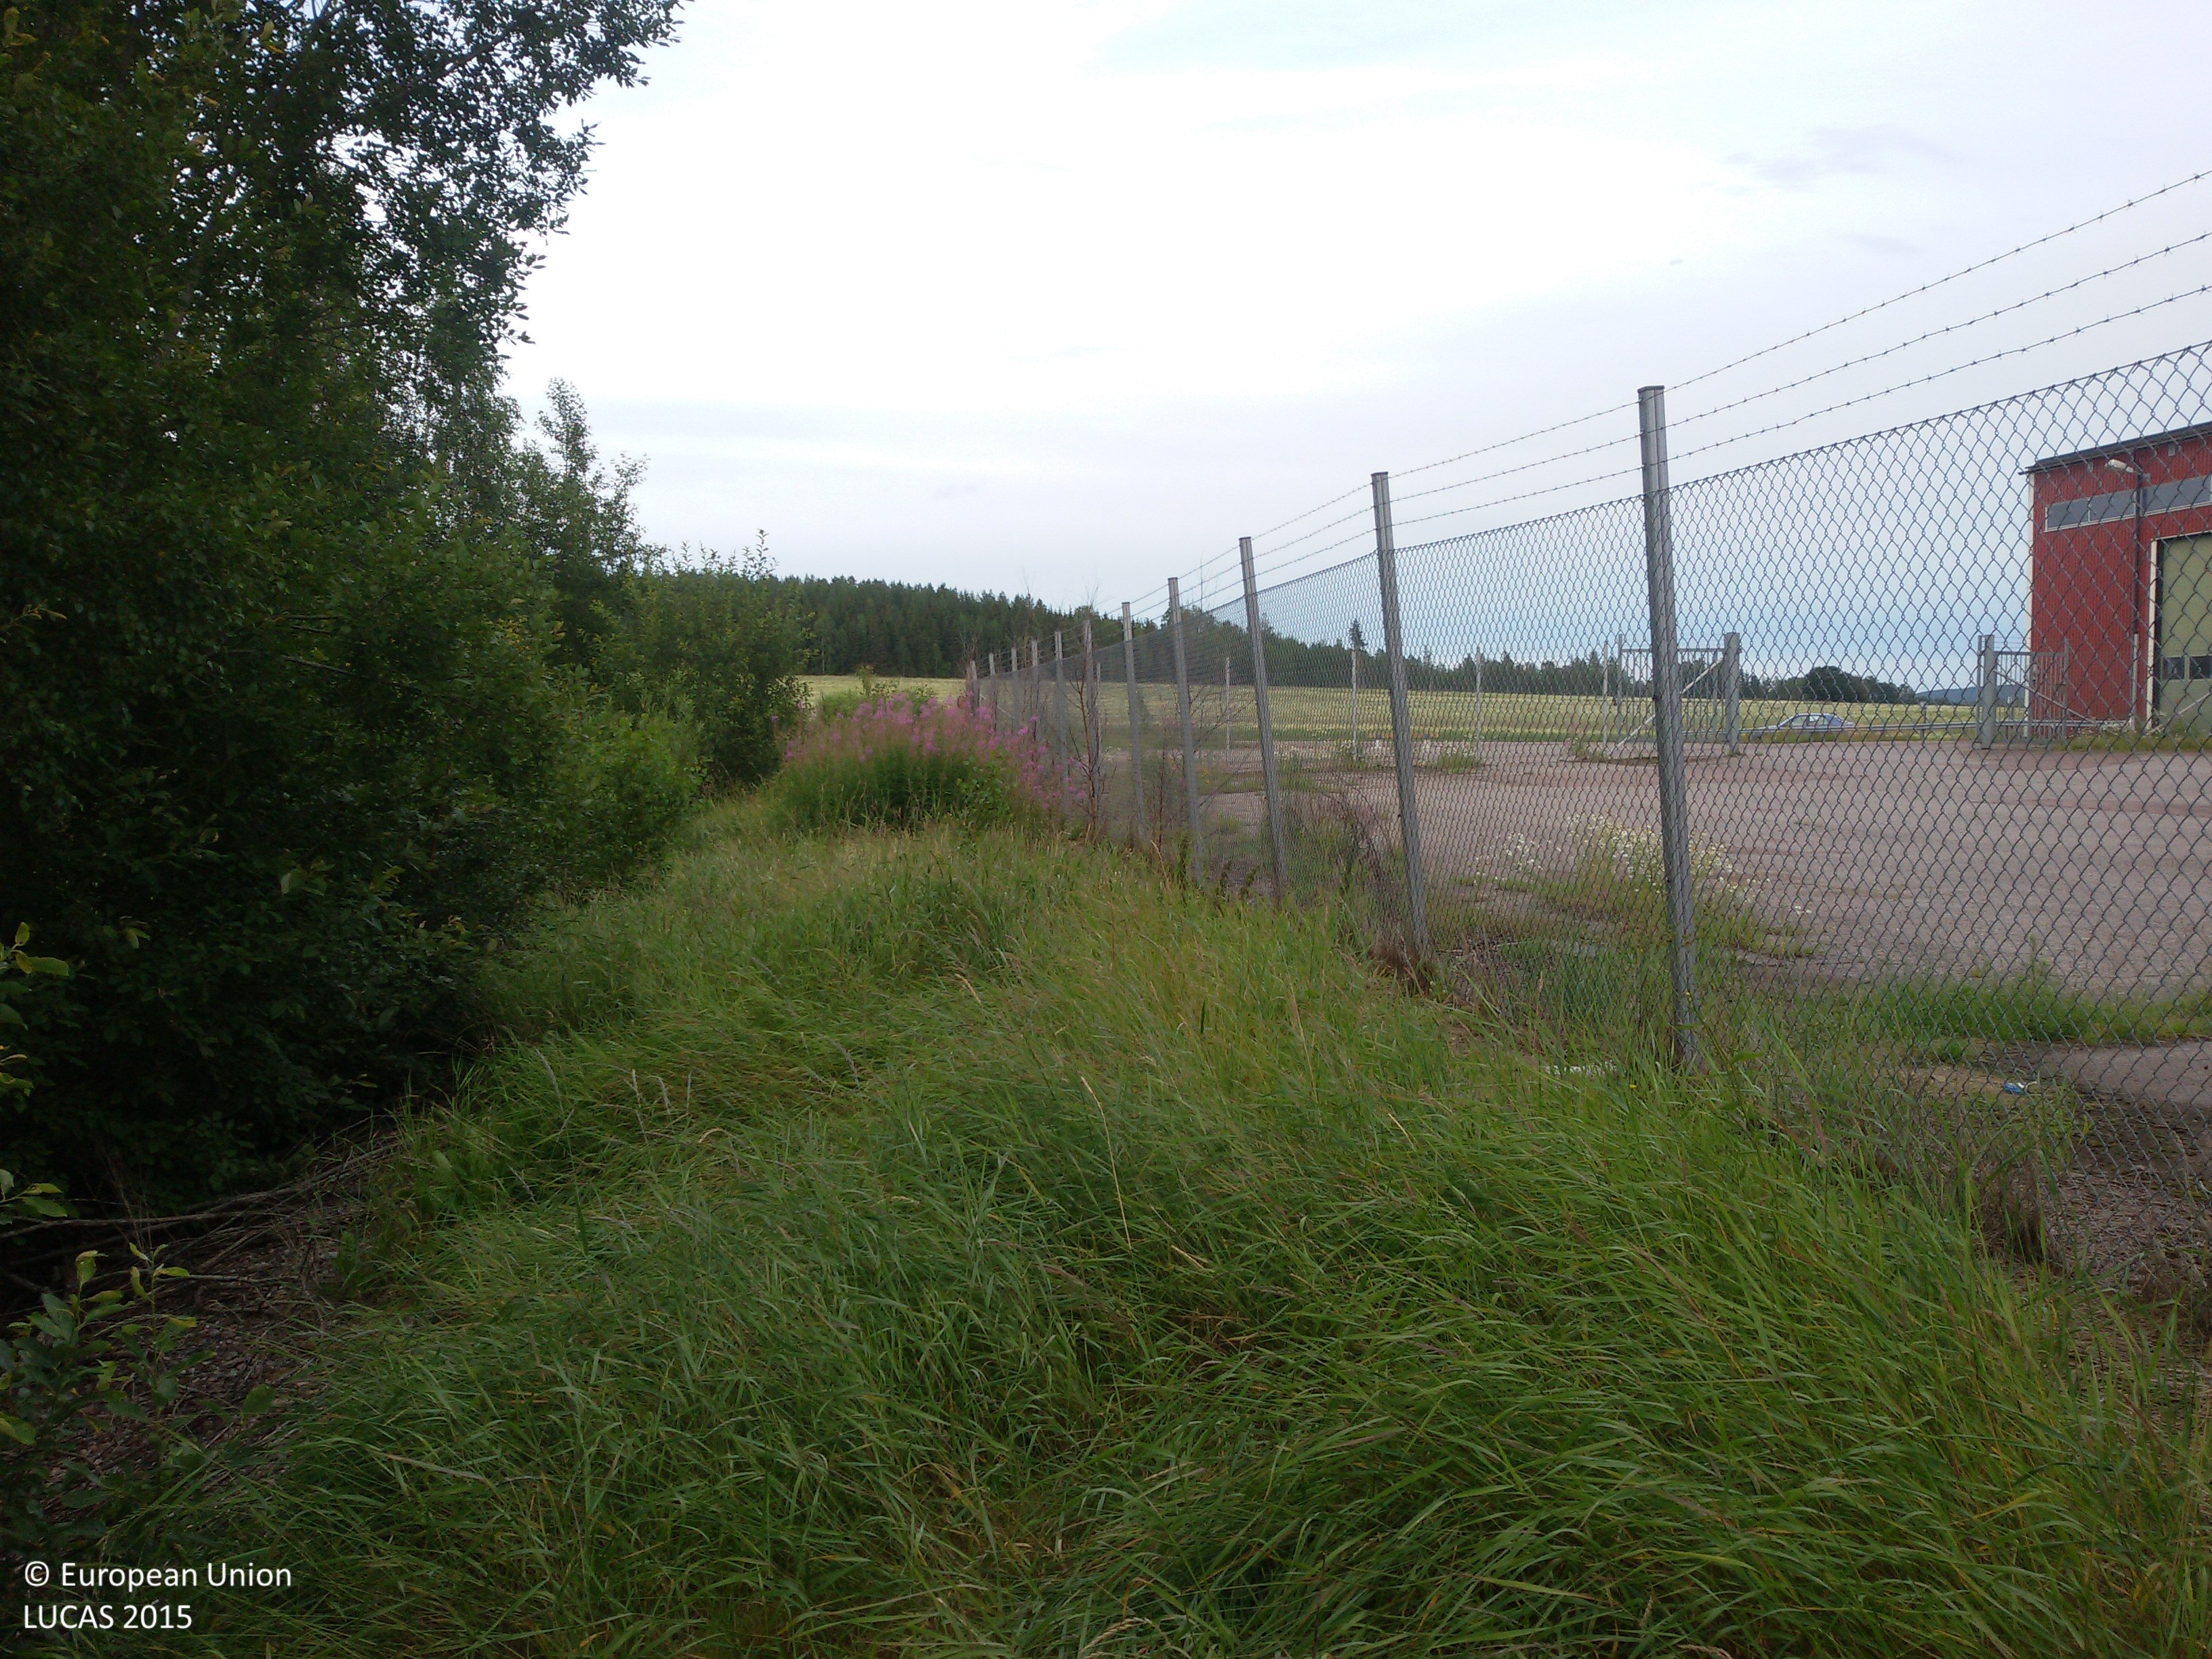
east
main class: Grassland
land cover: Spontaneously vegetated surfaces
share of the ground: > 75 %
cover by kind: herbaceous plants 100 %
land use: Semi-natural and natural areas not in use
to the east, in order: Spontaneously vegetated surfaces; Artificial constructions in urban areas; Grass margins; Common wheat
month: July
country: SE
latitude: 60.4039
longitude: 15.8149
